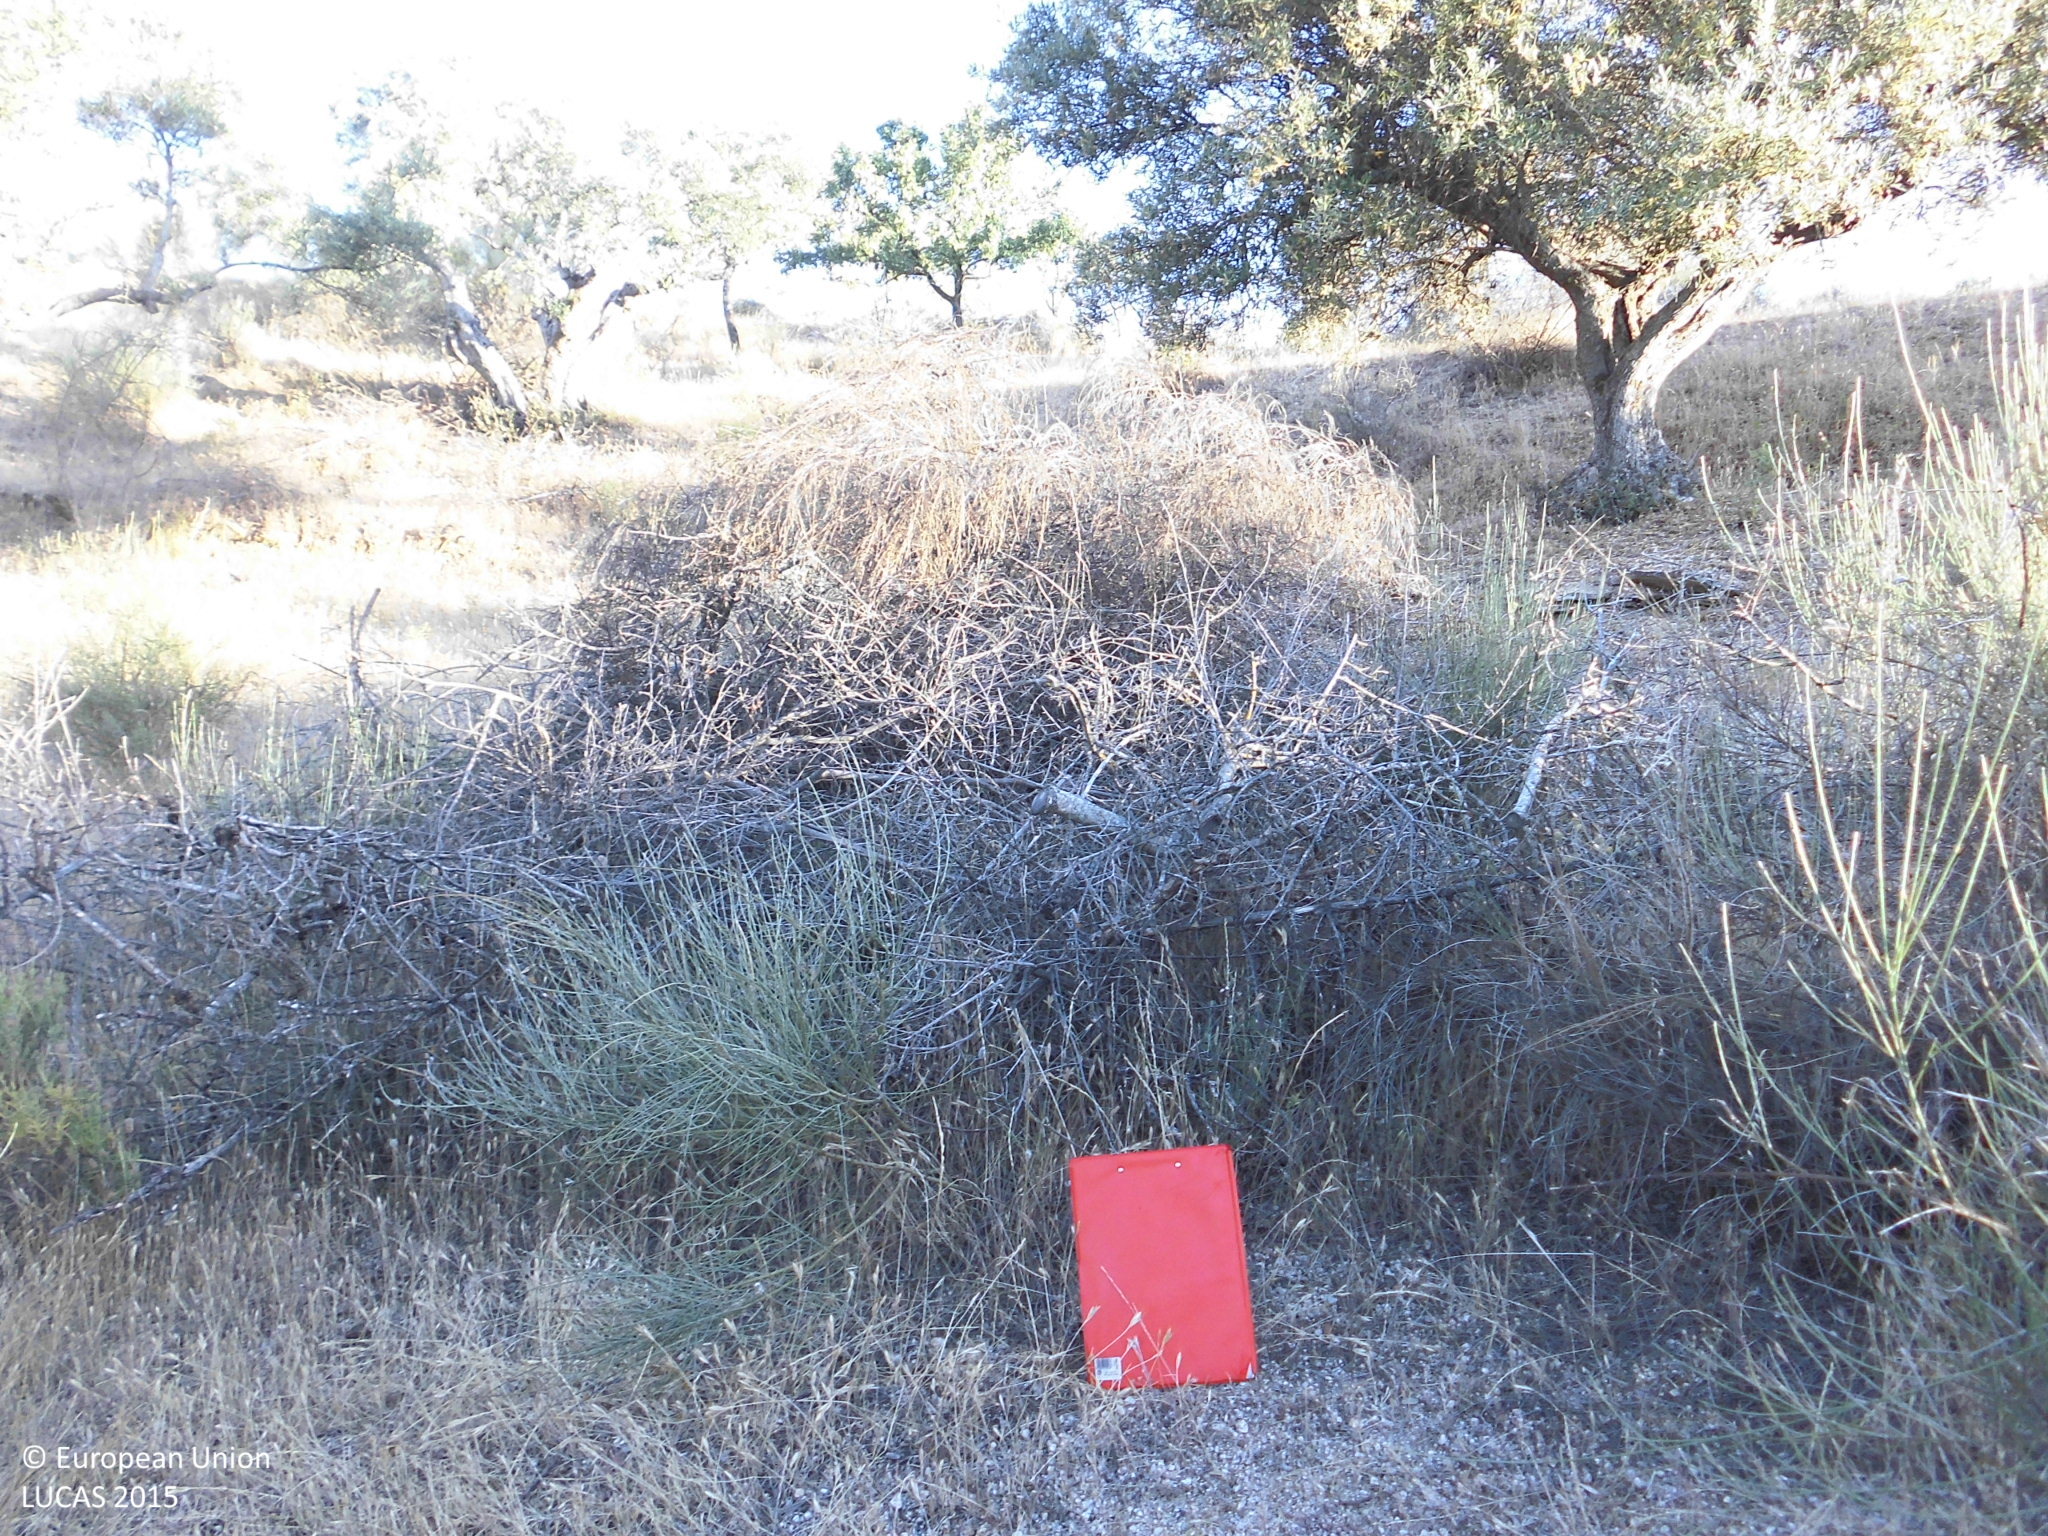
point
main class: Cropland
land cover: Olive groves
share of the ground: 10 - 25 %
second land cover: Spontaneously vegetated surfaces
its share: 50 - 75 %
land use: Agriculture (excluding fallow land and kitchen gardens)
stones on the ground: 10 - 25 %
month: May
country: ES
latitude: 39.7875
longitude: -6.6728
